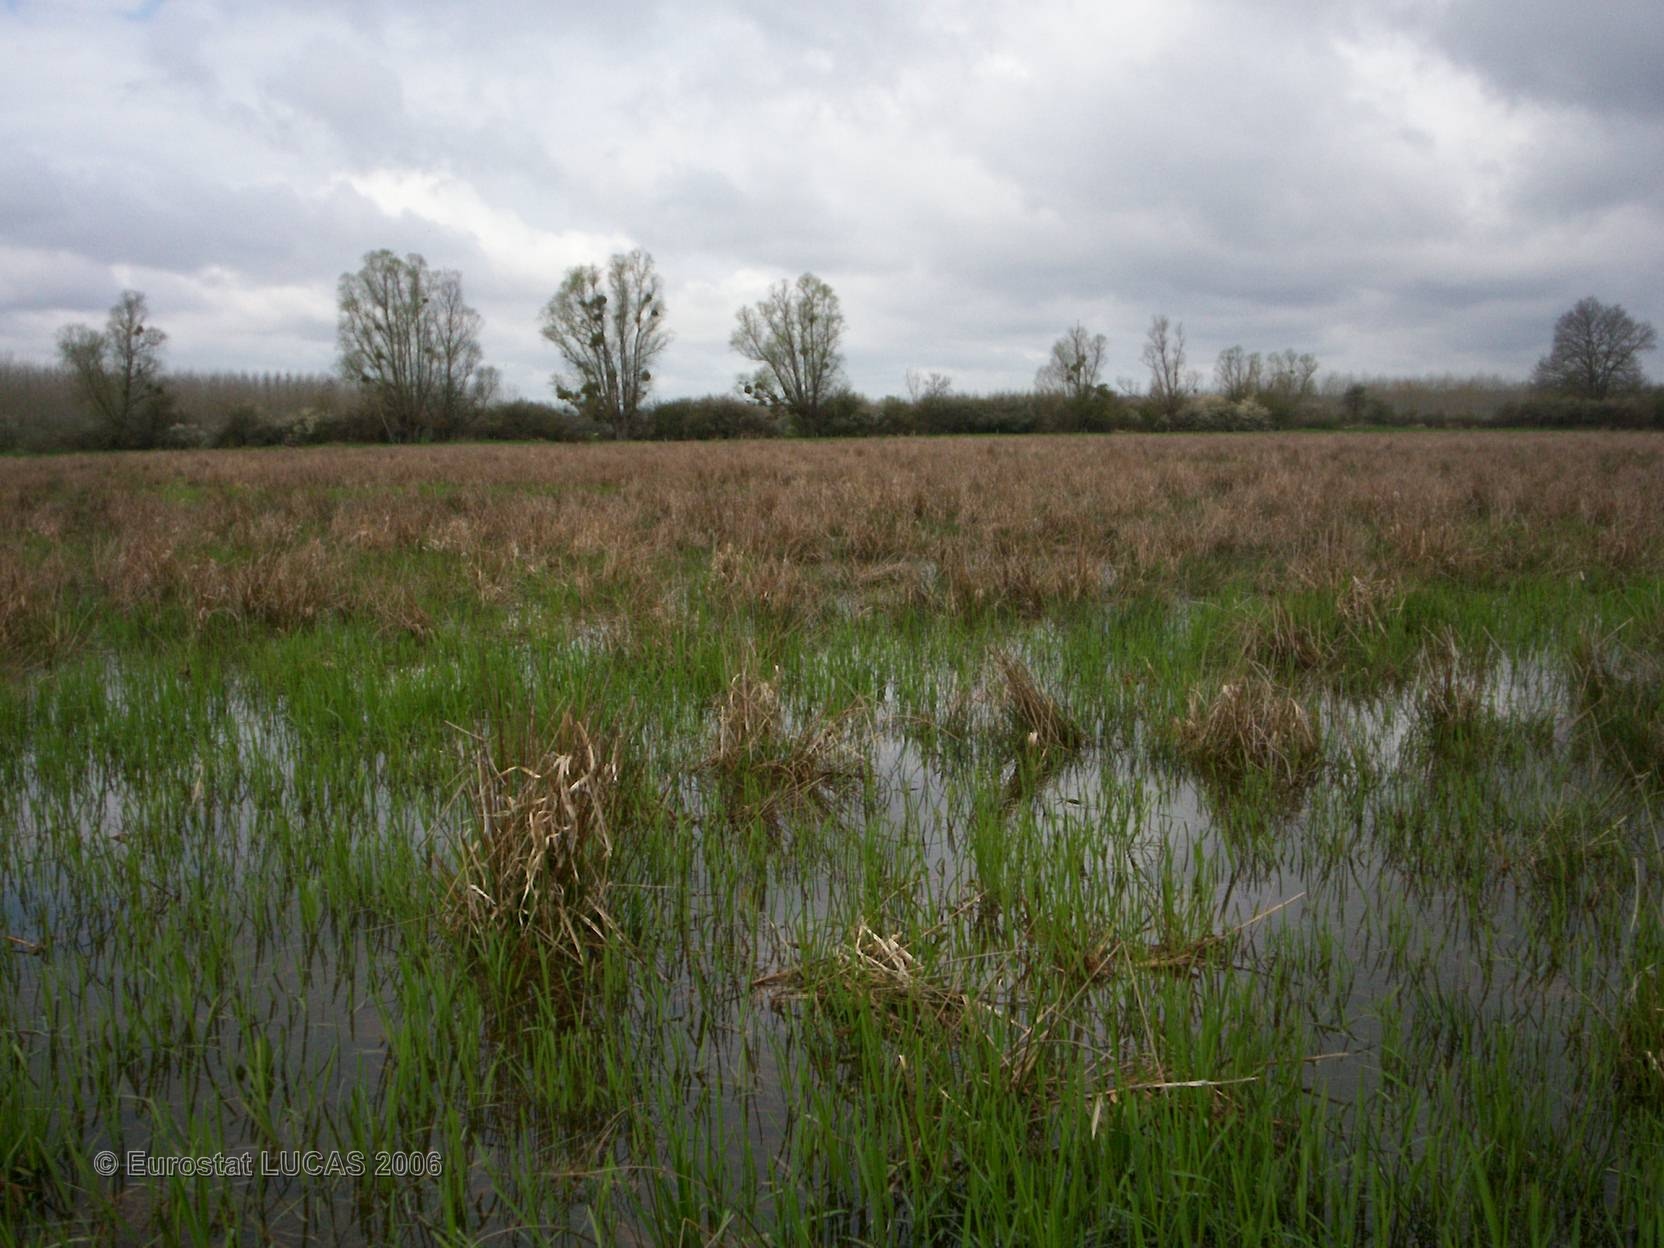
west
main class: Grassland
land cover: Grassland without tree/shrub cover
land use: Agriculture (excluding fallow land and kitchen gardens)
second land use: Wetland
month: April
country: FR
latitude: 46.8127
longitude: 3.0637
